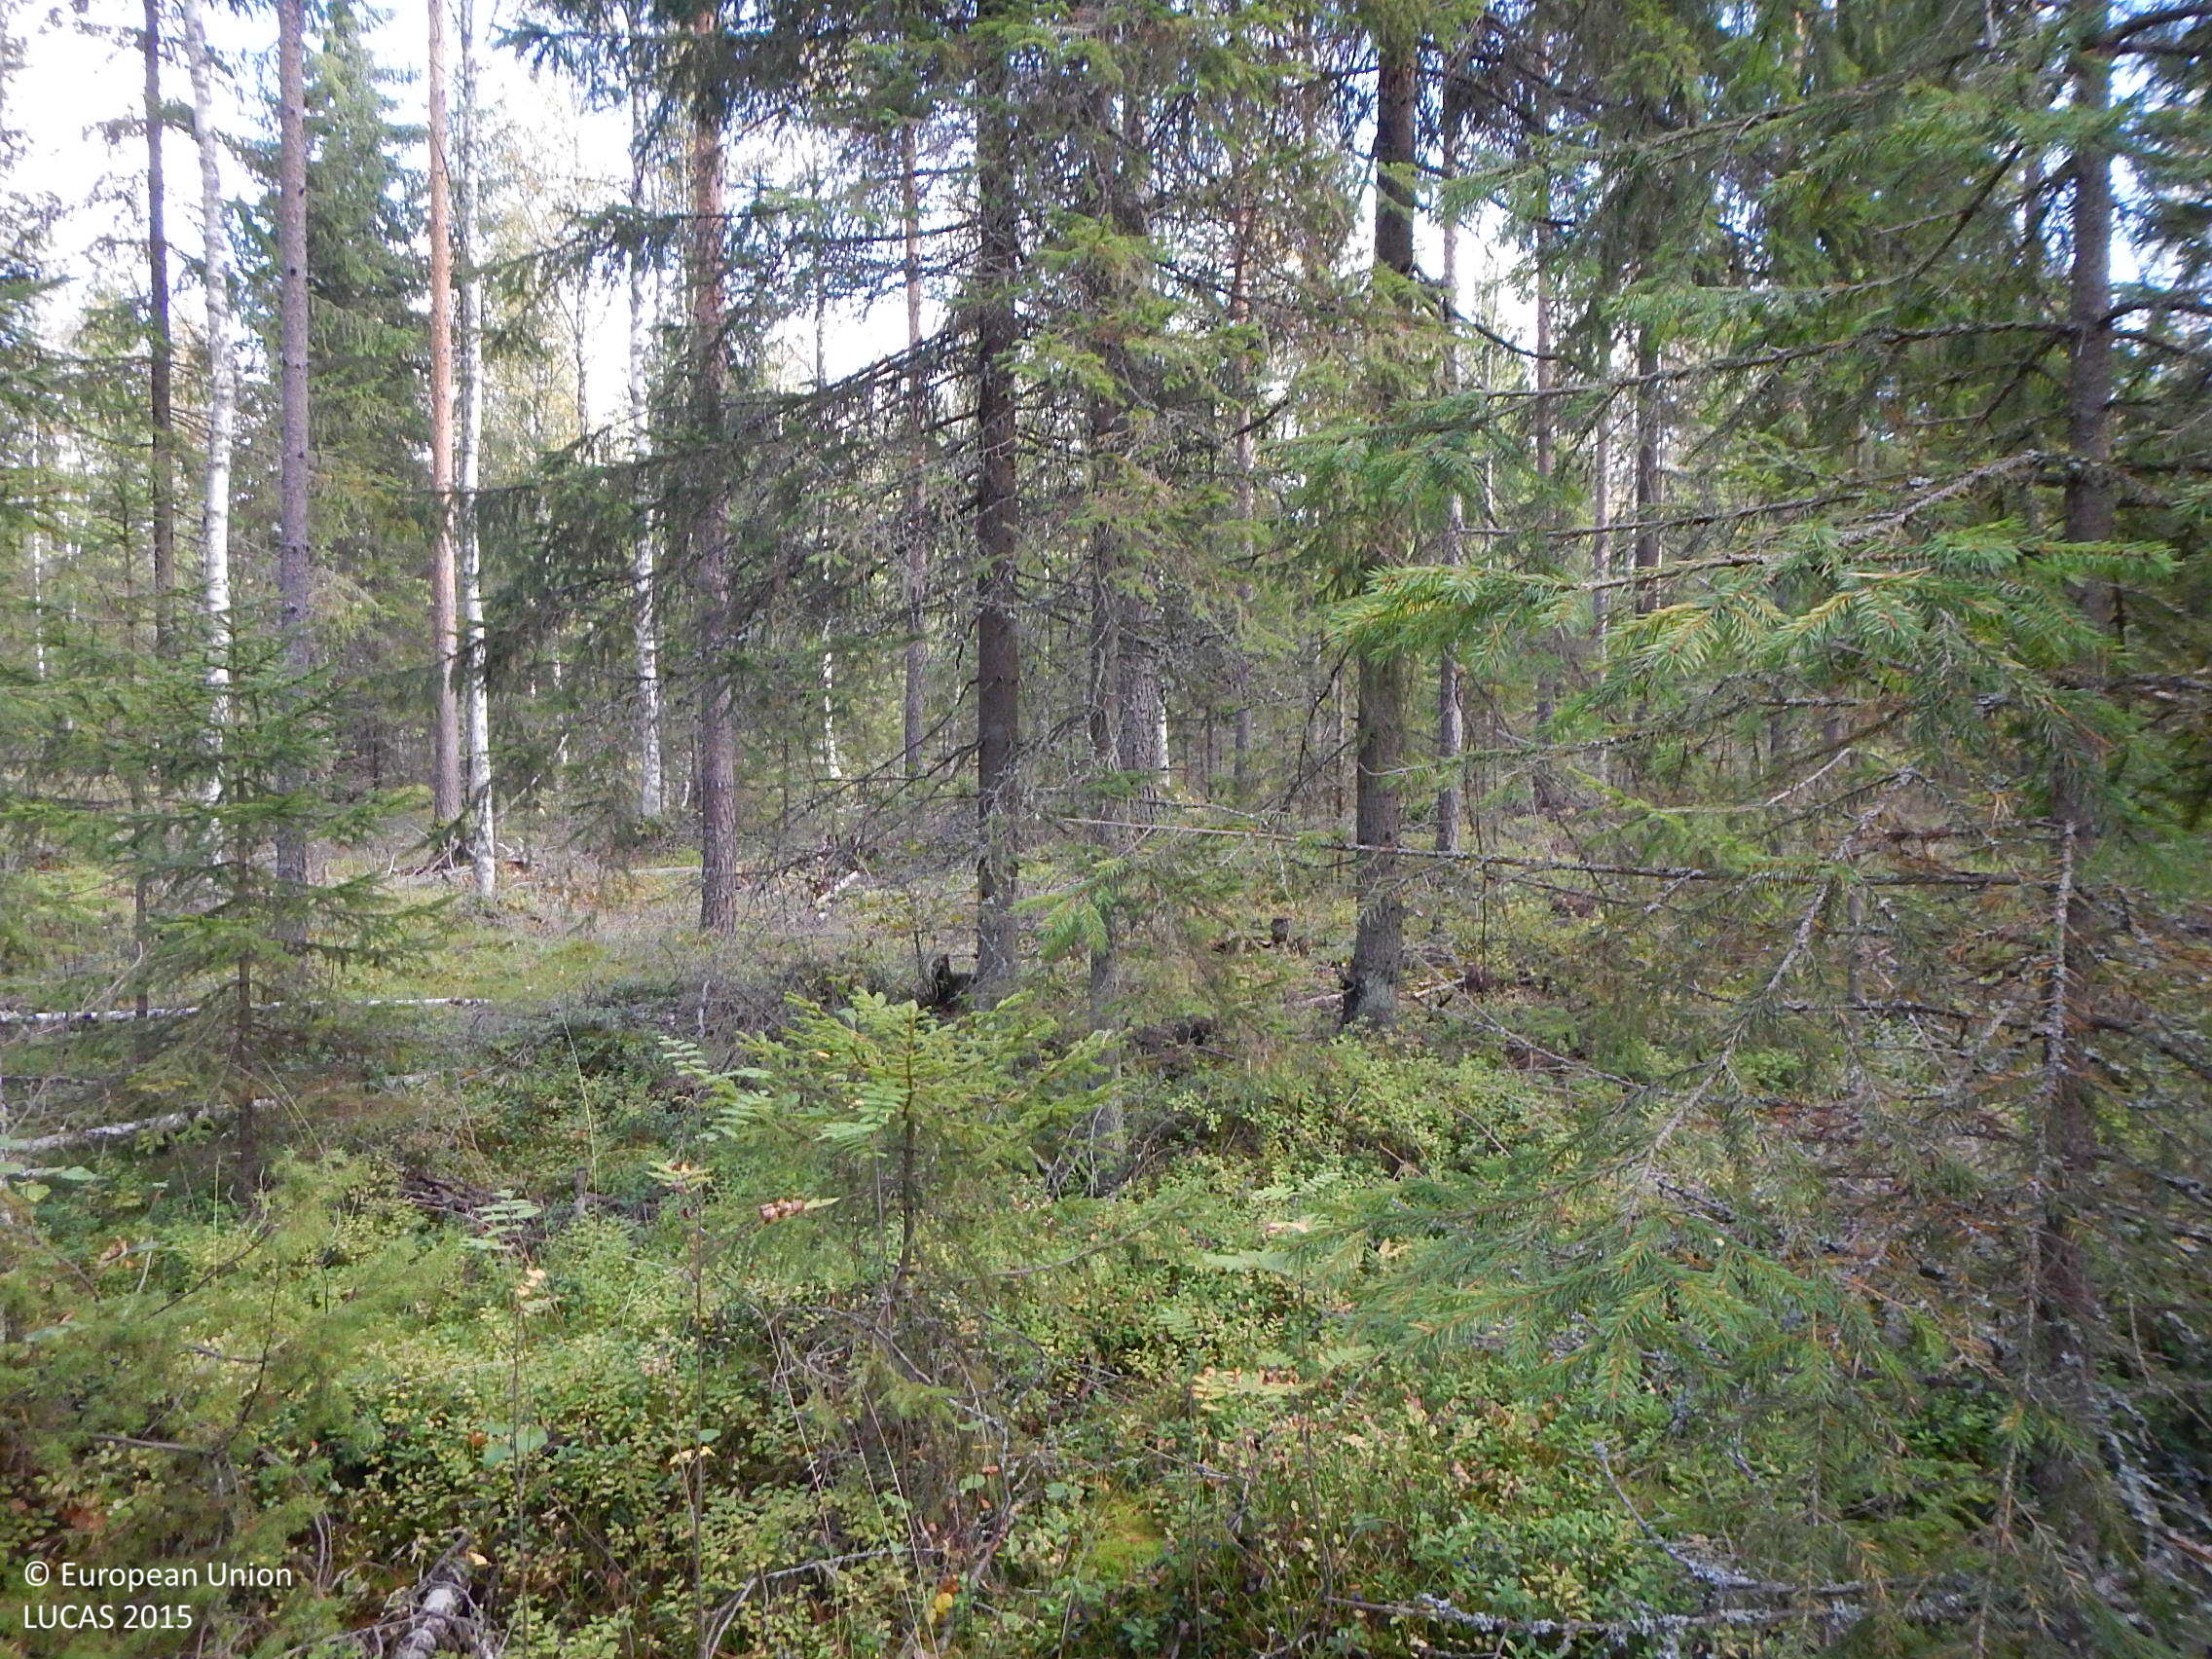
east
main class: Woodland
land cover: Other mixed woodland
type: boreal forest
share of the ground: > 75 %
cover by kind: coniferous forest trees 55 %, broadleaved forest trees 25 %, shrubs 20 %
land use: Forestry
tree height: > 5 m
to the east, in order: Other mixed woodland; Spruce dominated coniferous woodland; Tracks; Spruce dominated coniferous woodland; Ditches and canals; Spruce dominated coniferous woodland
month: September
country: FI
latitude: 61.9551
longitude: 22.7810
